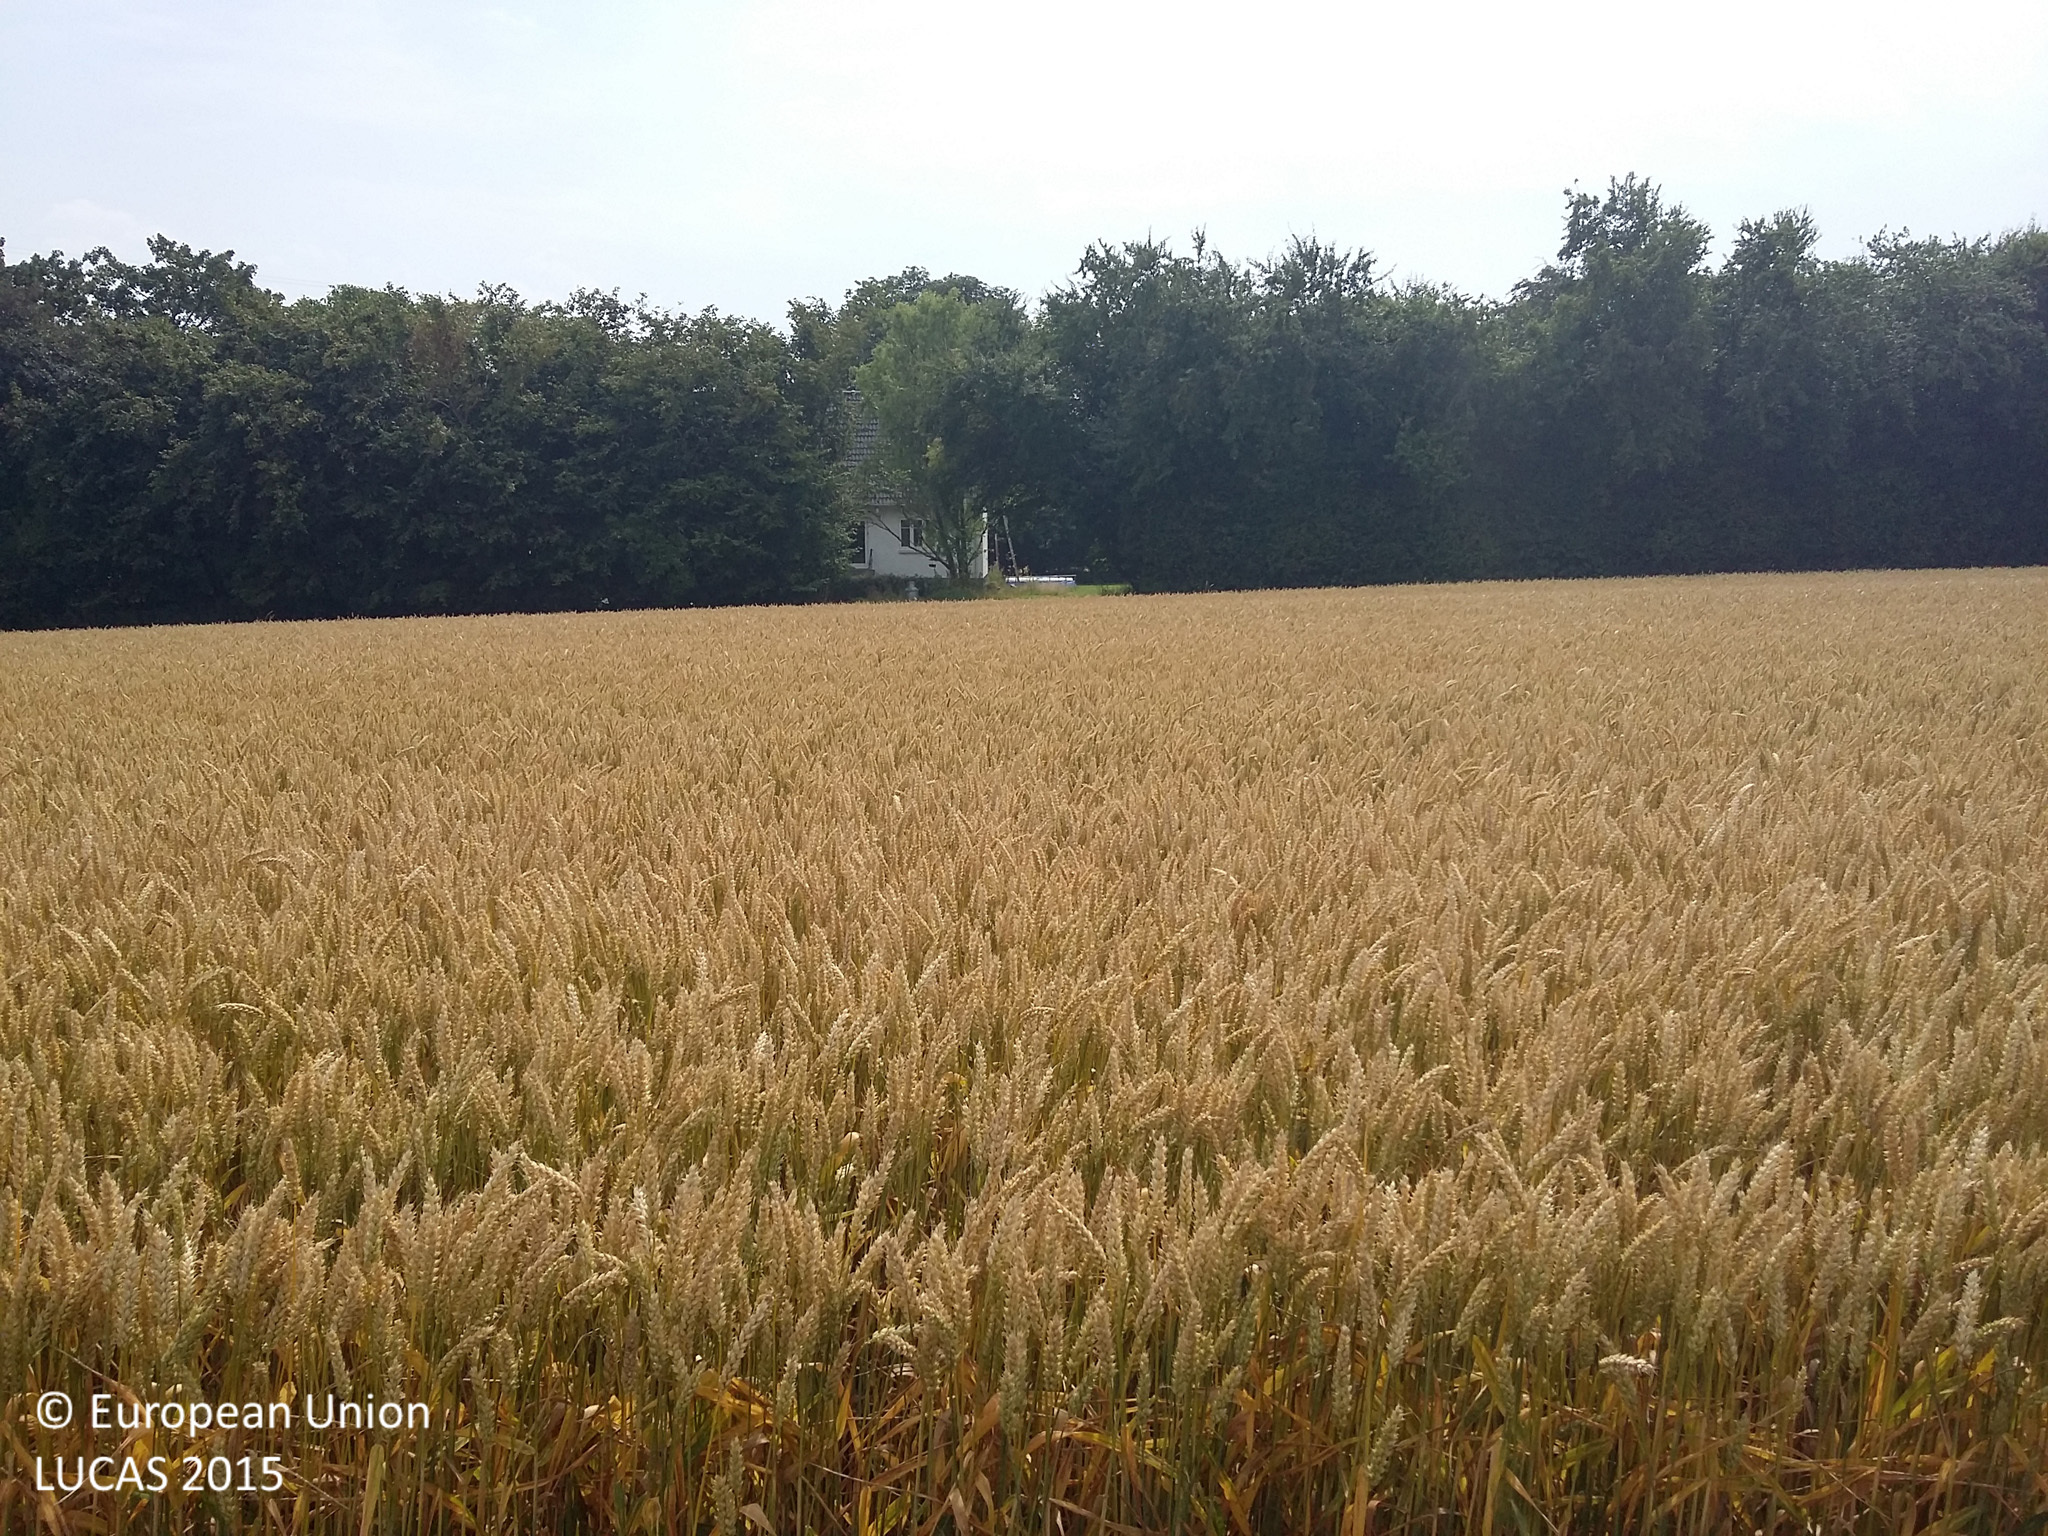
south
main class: Cropland
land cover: Rape and turnip rape
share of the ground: > 75 %
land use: Agriculture (excluding fallow land and kitchen gardens)
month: August
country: DK
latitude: 55.4873
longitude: 12.1031
